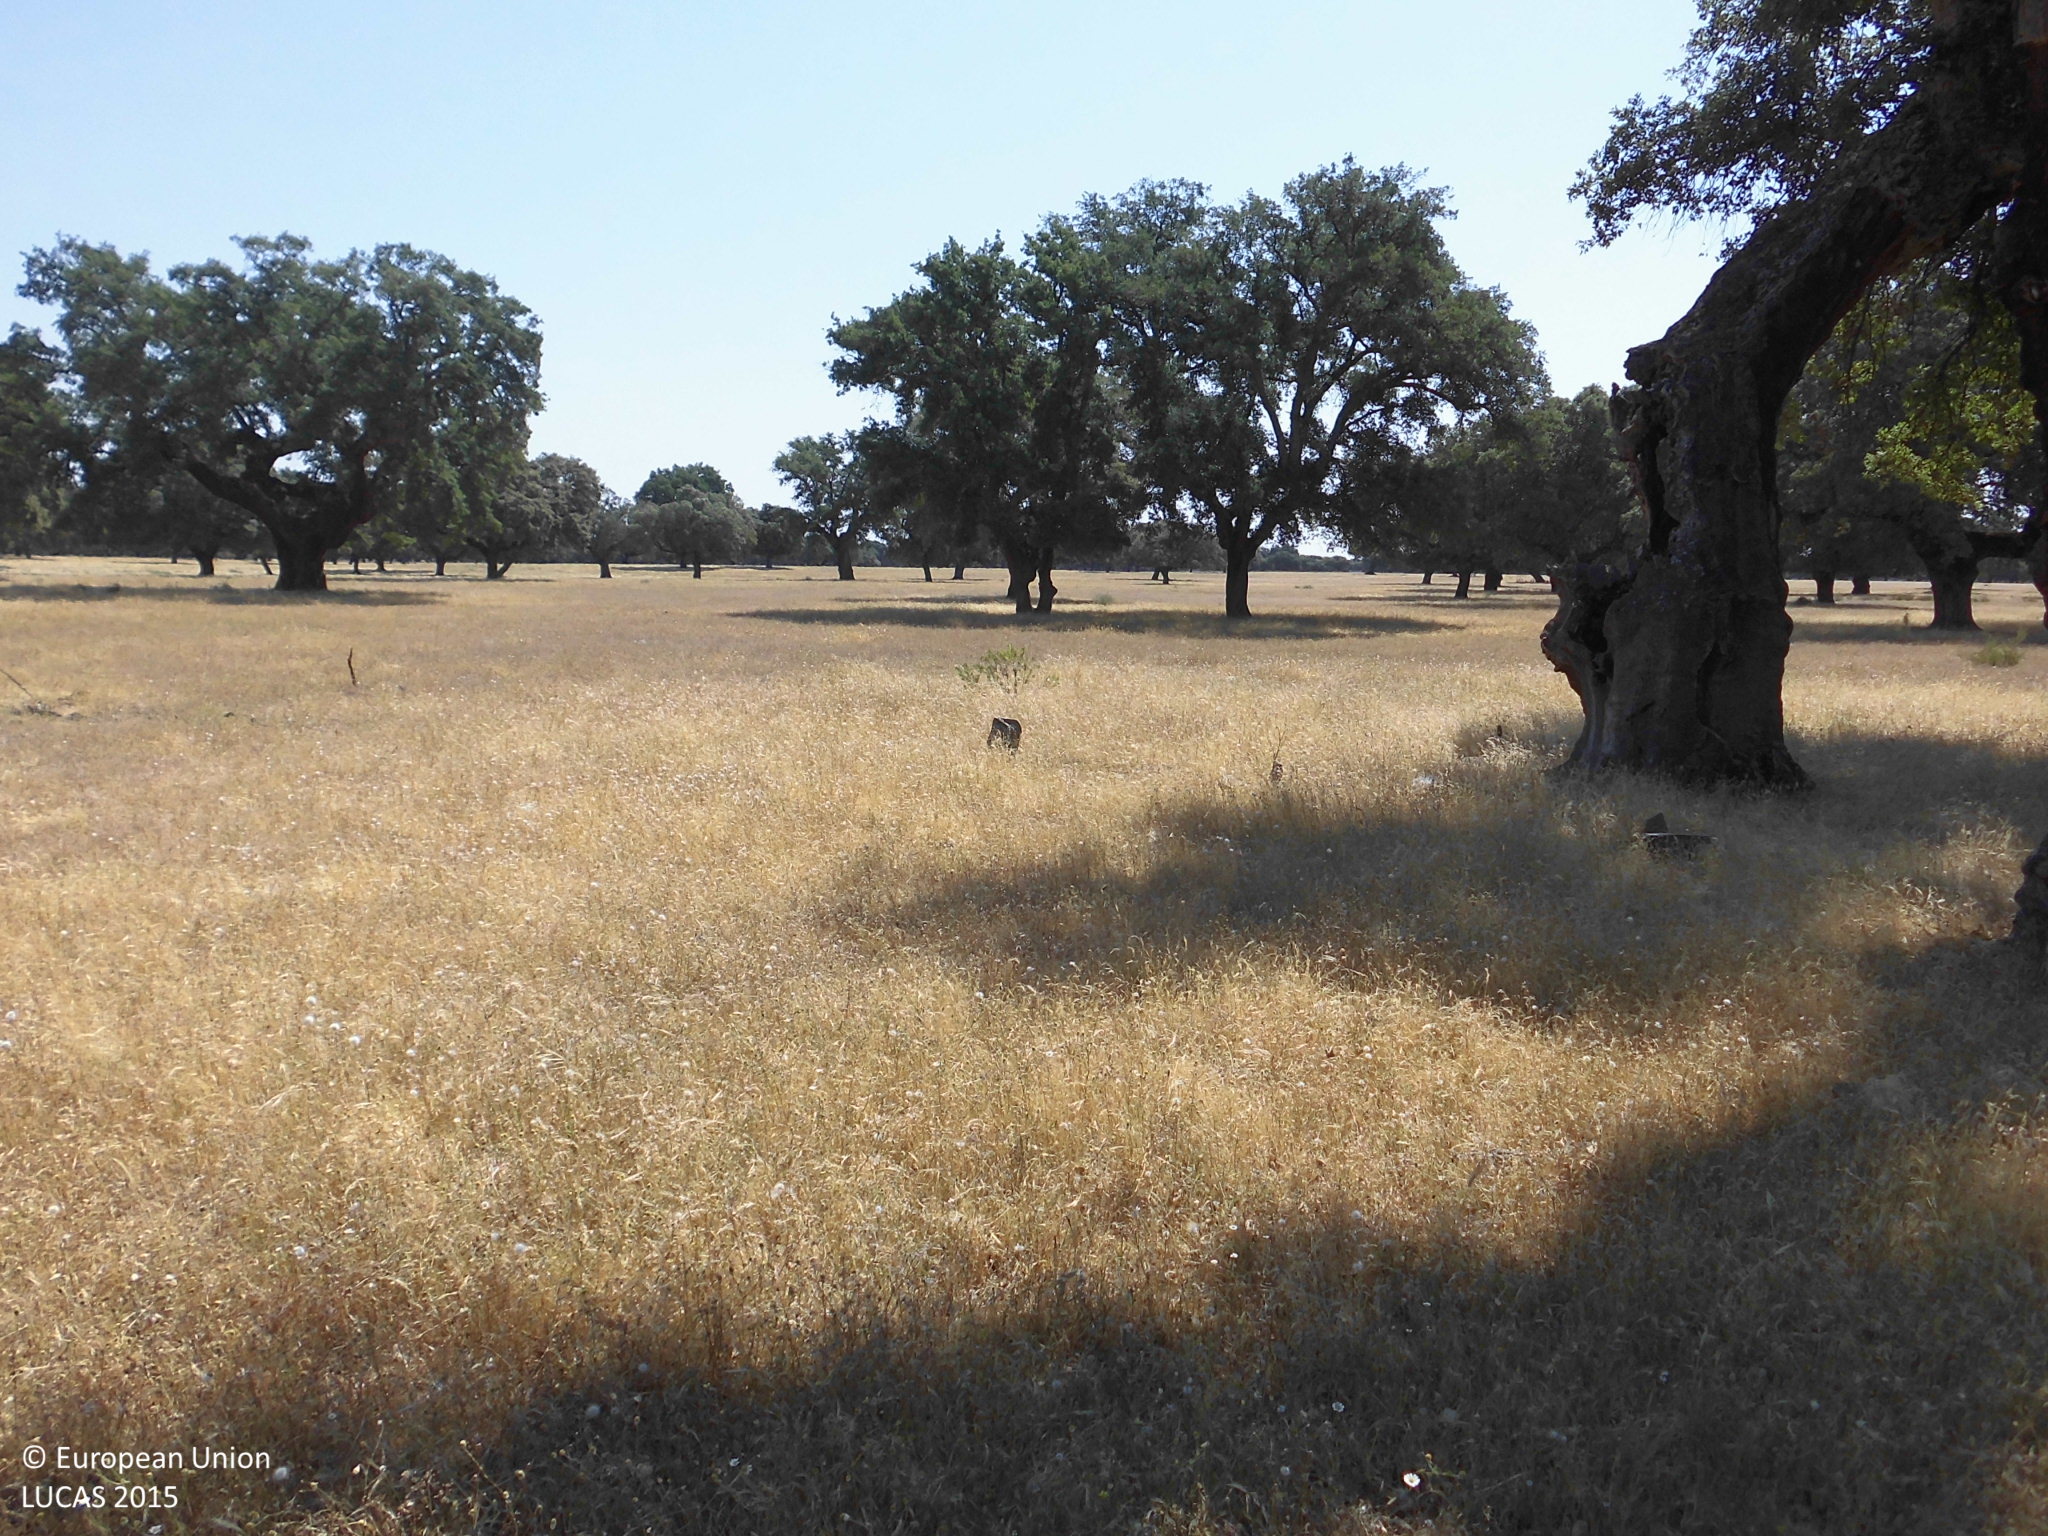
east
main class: Woodland
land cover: Broadleaved woodland
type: broadleaved evergreen forest
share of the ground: 25 - 50 %
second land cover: Grassland without tree/shrub cover
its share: > 75 %
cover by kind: herbaceous plants 75 %, broadleaved forest trees 25 %
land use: Forestry
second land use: Agriculture (excluding fallow land and kitchen gardens)
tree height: > 5 m
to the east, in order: Broadleaved woodland; Grassland without tree/shrub cover; Broadleaved woodland
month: June
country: ES
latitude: 39.9364
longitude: -5.4465
